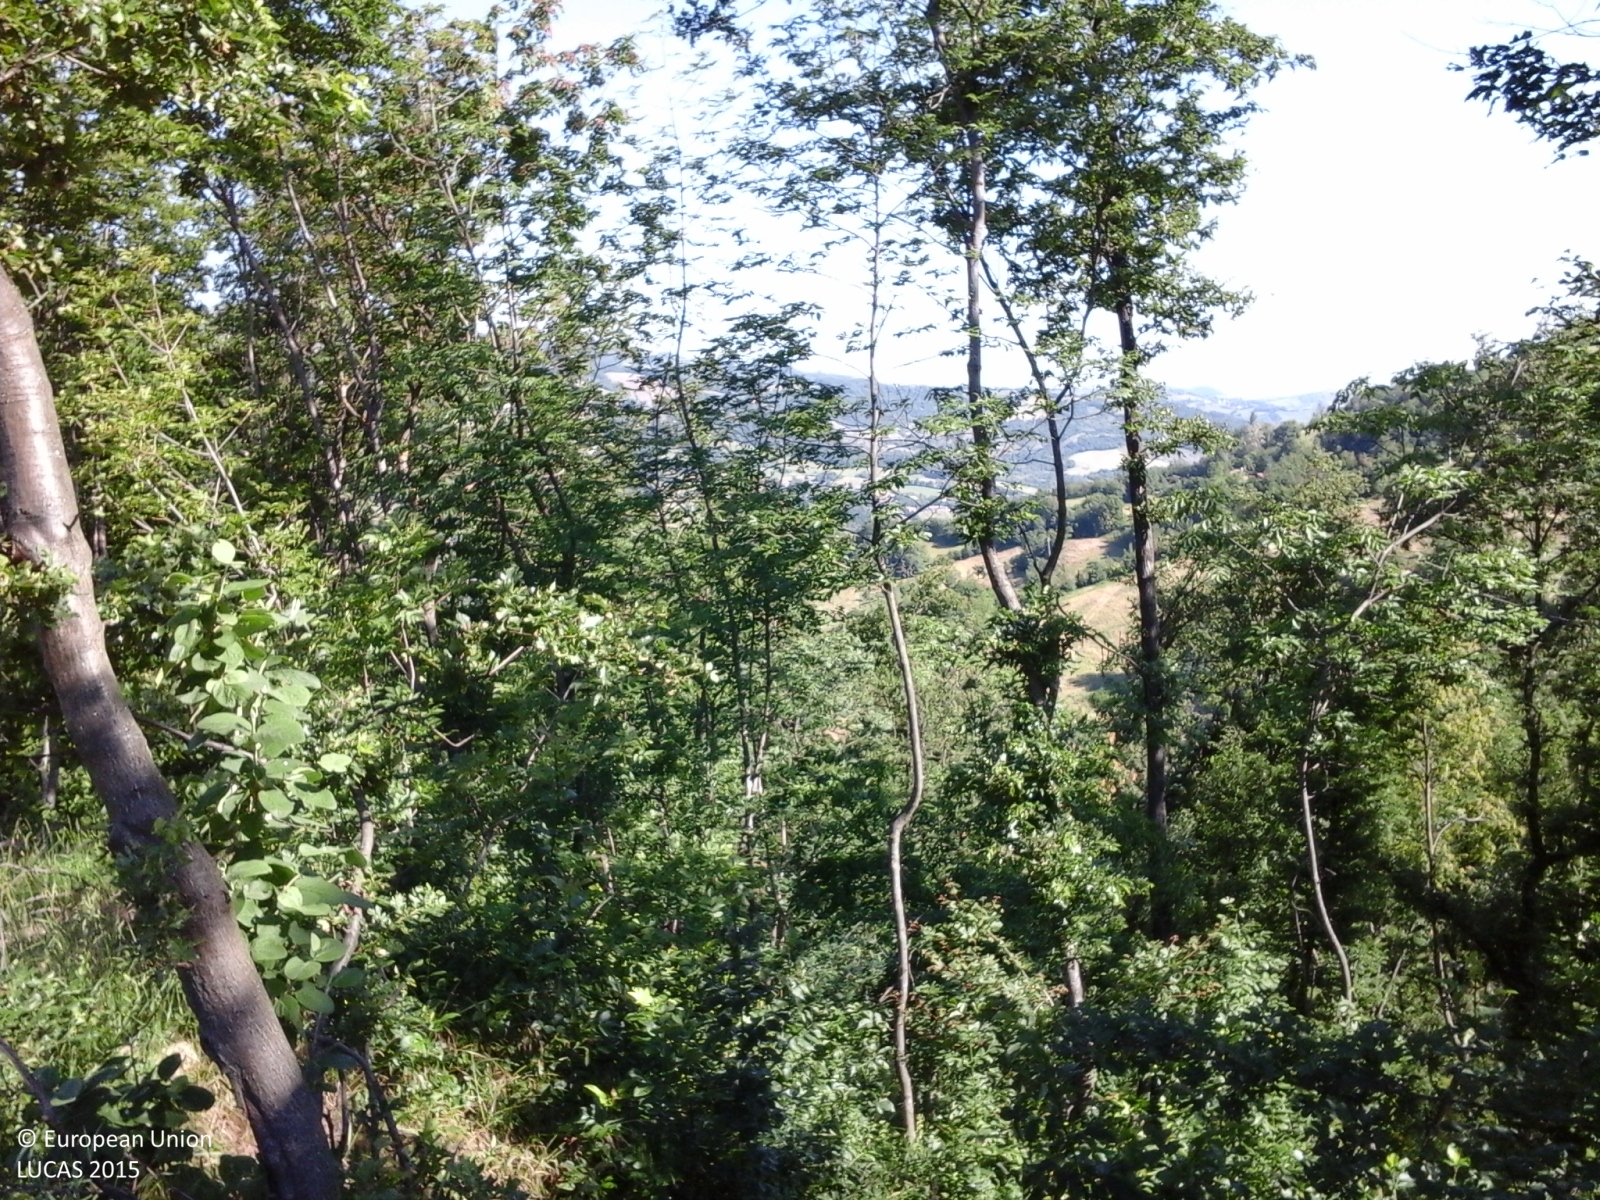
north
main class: Woodland
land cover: Broadleaved woodland
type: thermophilous deciduous forest
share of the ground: > 75 %
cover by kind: broadleaved forest trees 90 %, shrubs 5 %, herbaceous plants 5 %
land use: Forestry
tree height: > 5 m
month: May
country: IT
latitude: 44.4027
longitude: 10.6389
